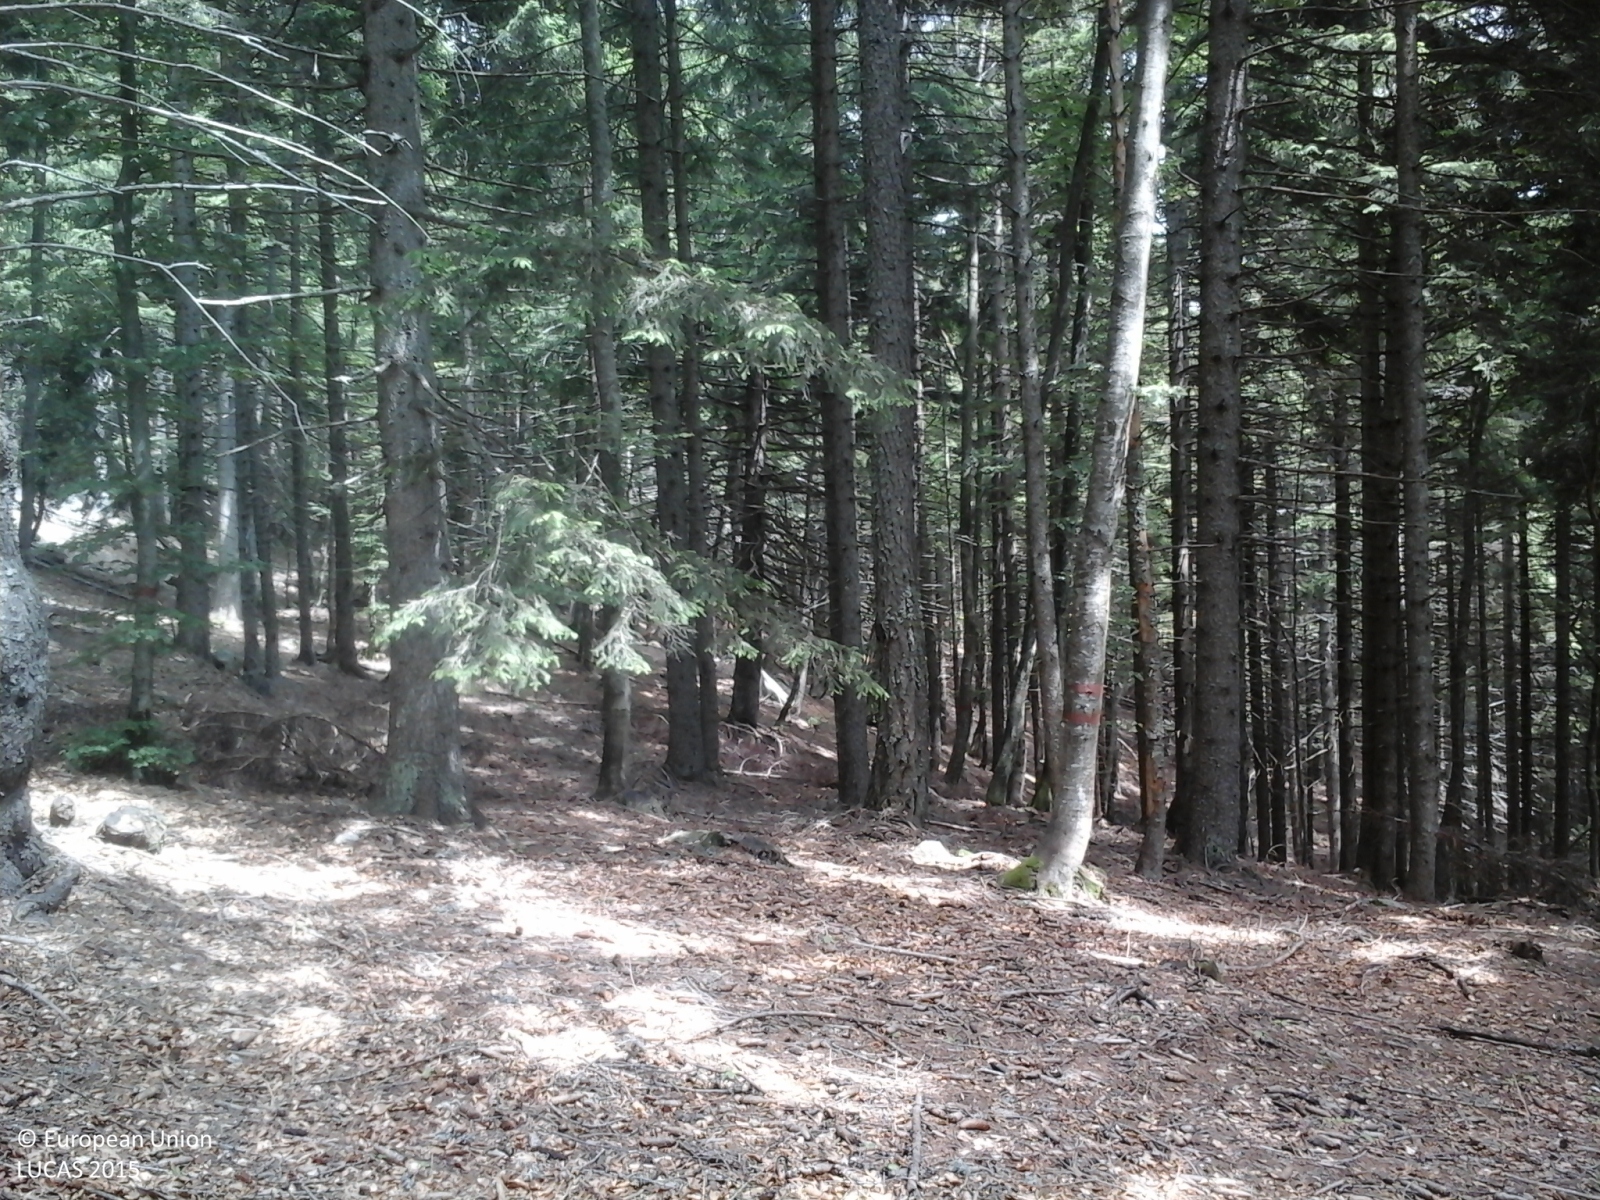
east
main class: Woodland
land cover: Other coniferous woodland
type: alpine coniferous forest
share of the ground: > 75 %
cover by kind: coniferous forest trees 95 %, broadleaved forest trees 5 %
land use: Forestry
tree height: > 5 m
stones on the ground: 10 - 25 %
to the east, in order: Other coniferous woodland
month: June
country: IT
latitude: 46.1404
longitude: 8.3582
